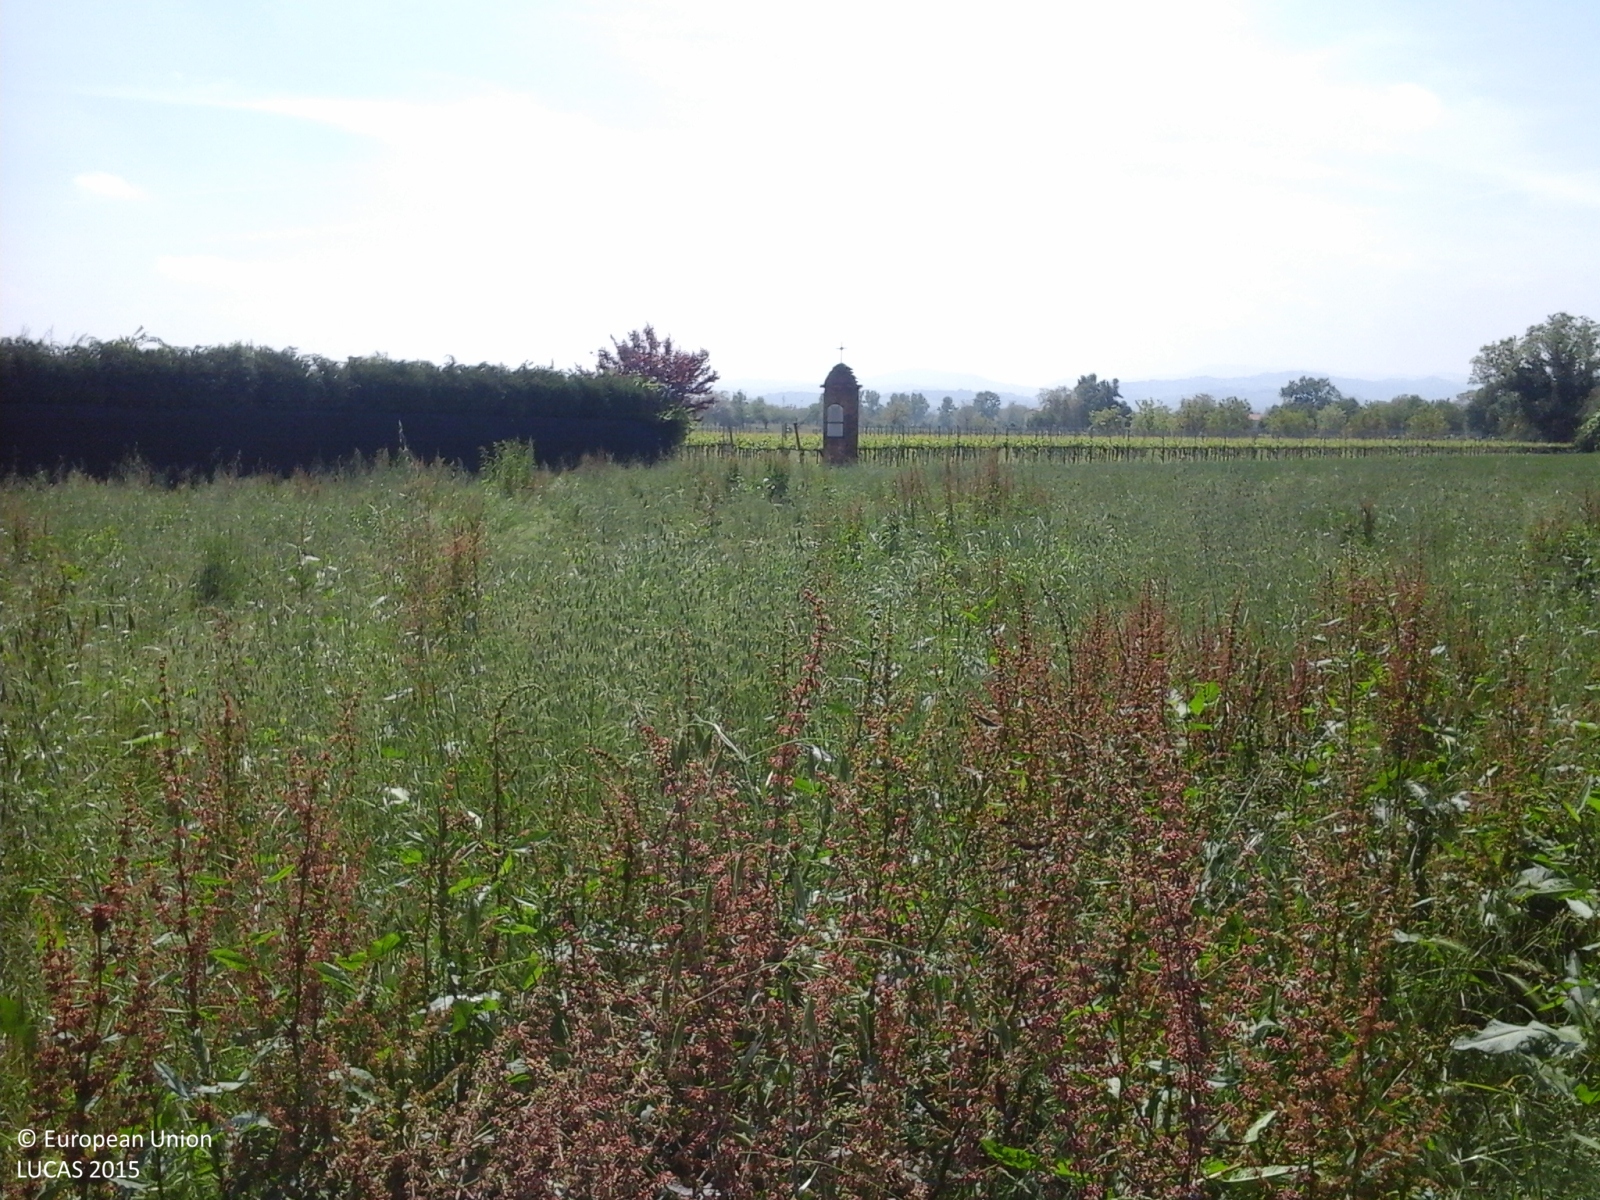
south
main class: Grassland
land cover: Spontaneously vegetated surfaces
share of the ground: > 75 %
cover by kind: herbaceous plants 100 %
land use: Agriculture (excluding fallow land and kitchen gardens)
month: May
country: IT
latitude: 44.5634
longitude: 10.8669
